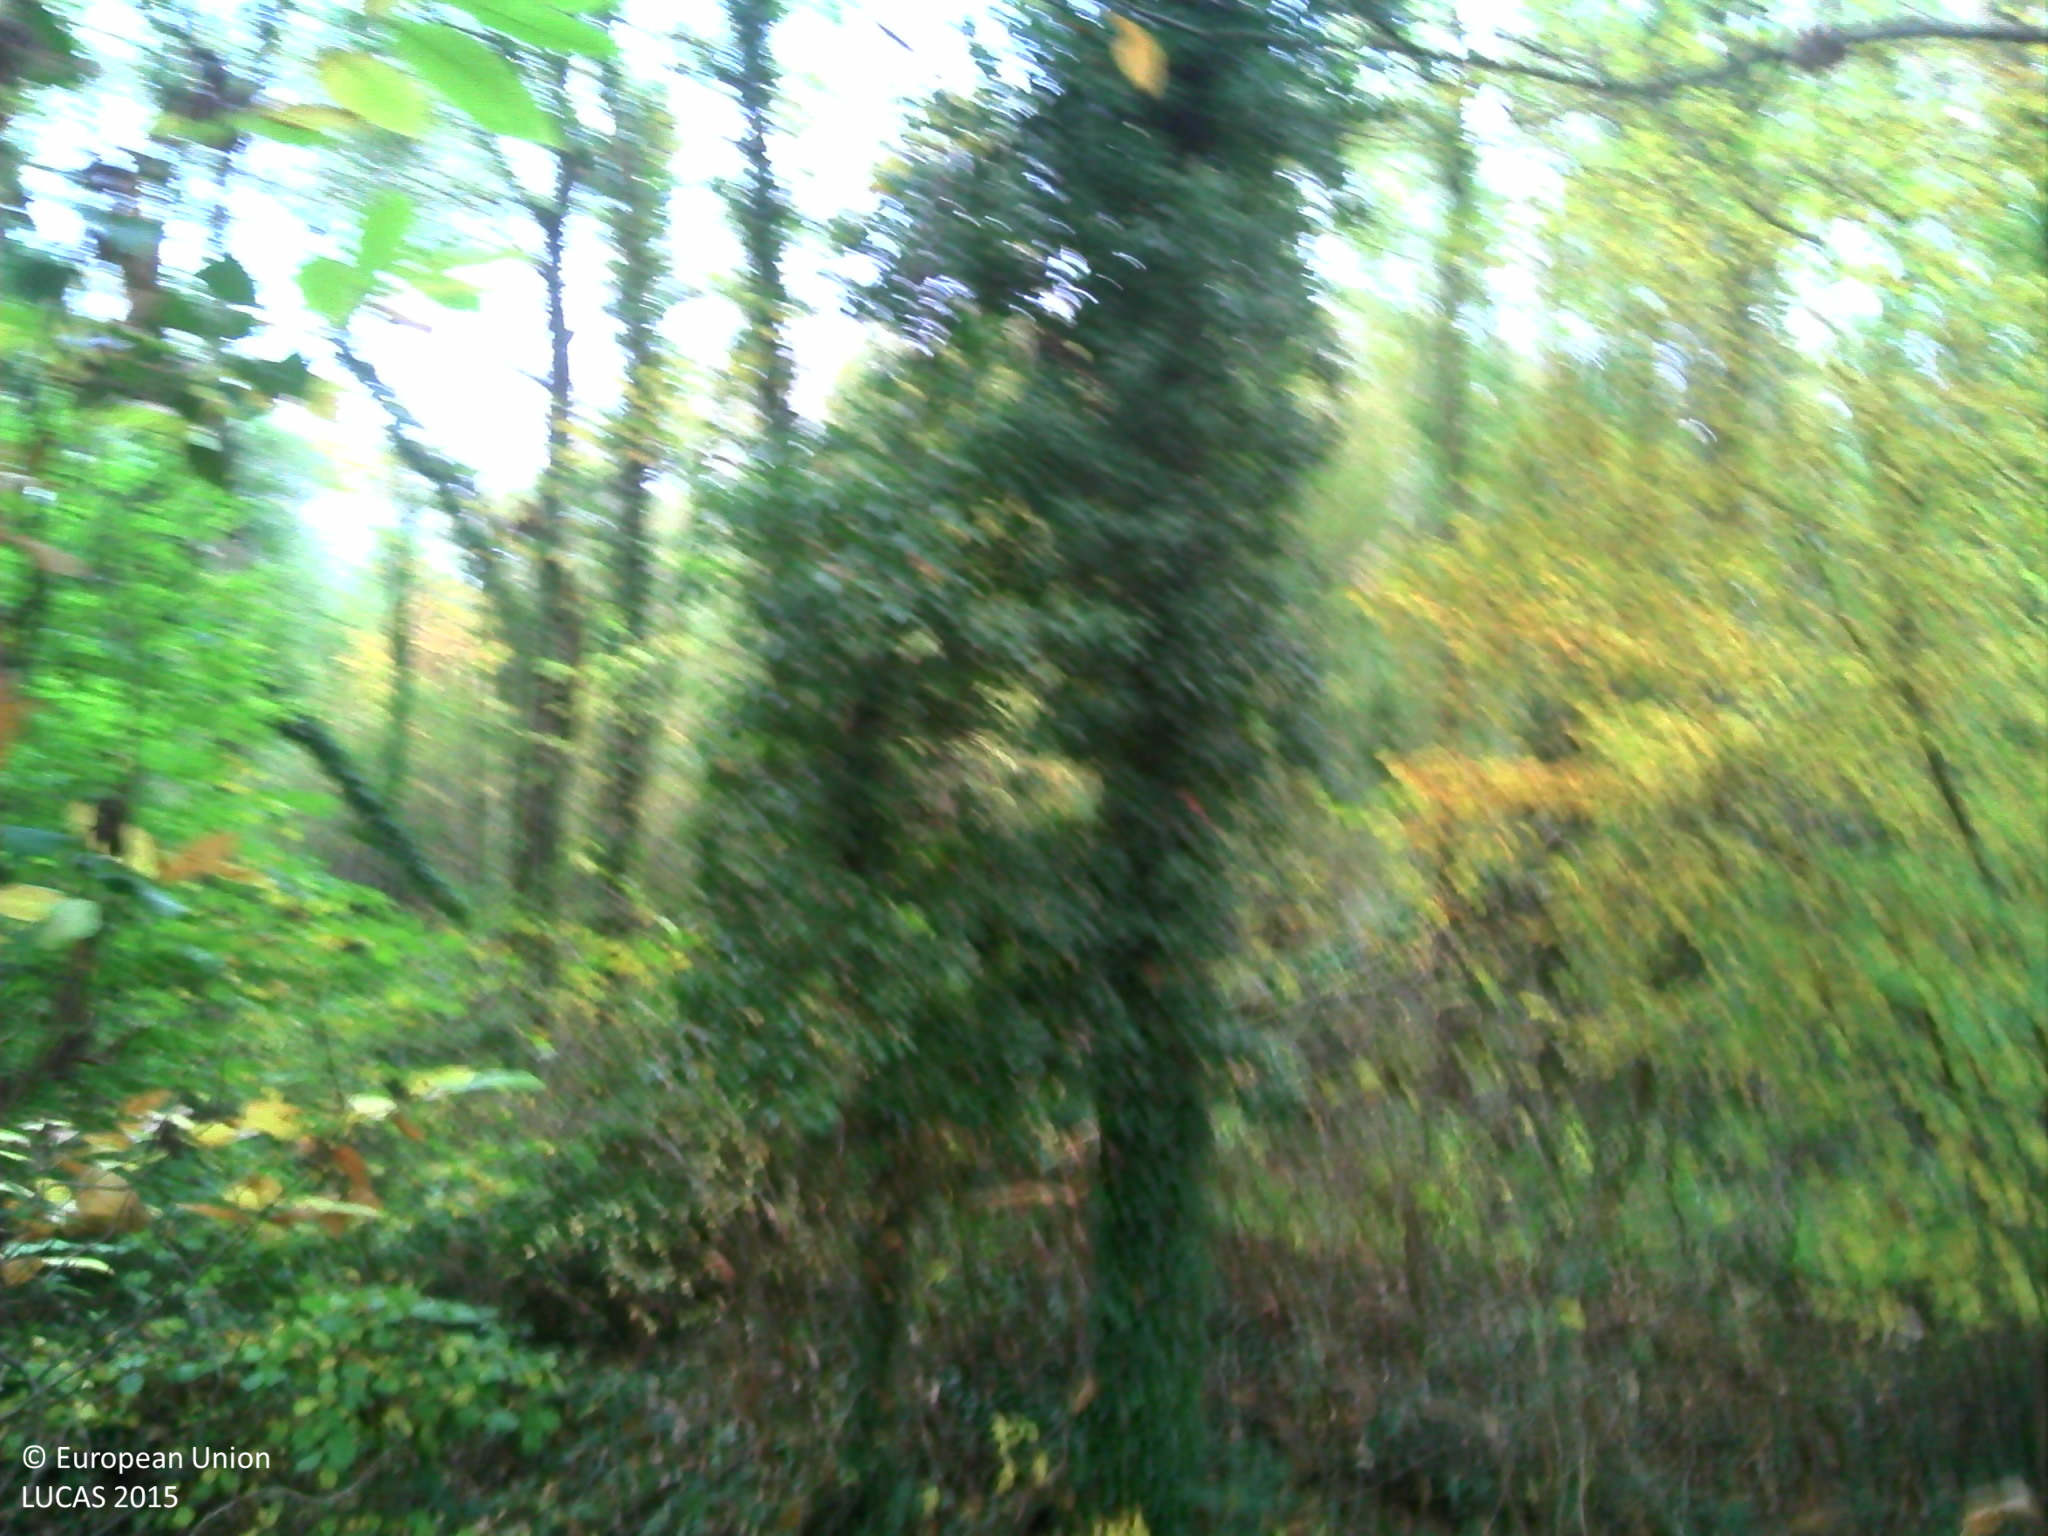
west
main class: Woodland
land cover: Broadleaved woodland
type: acidophilous oak and oak-birch forest
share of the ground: > 75 %
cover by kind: broadleaved forest trees 100 %
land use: Forestry
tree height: > 5 m
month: November
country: FR
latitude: 48.1234
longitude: -3.0059
